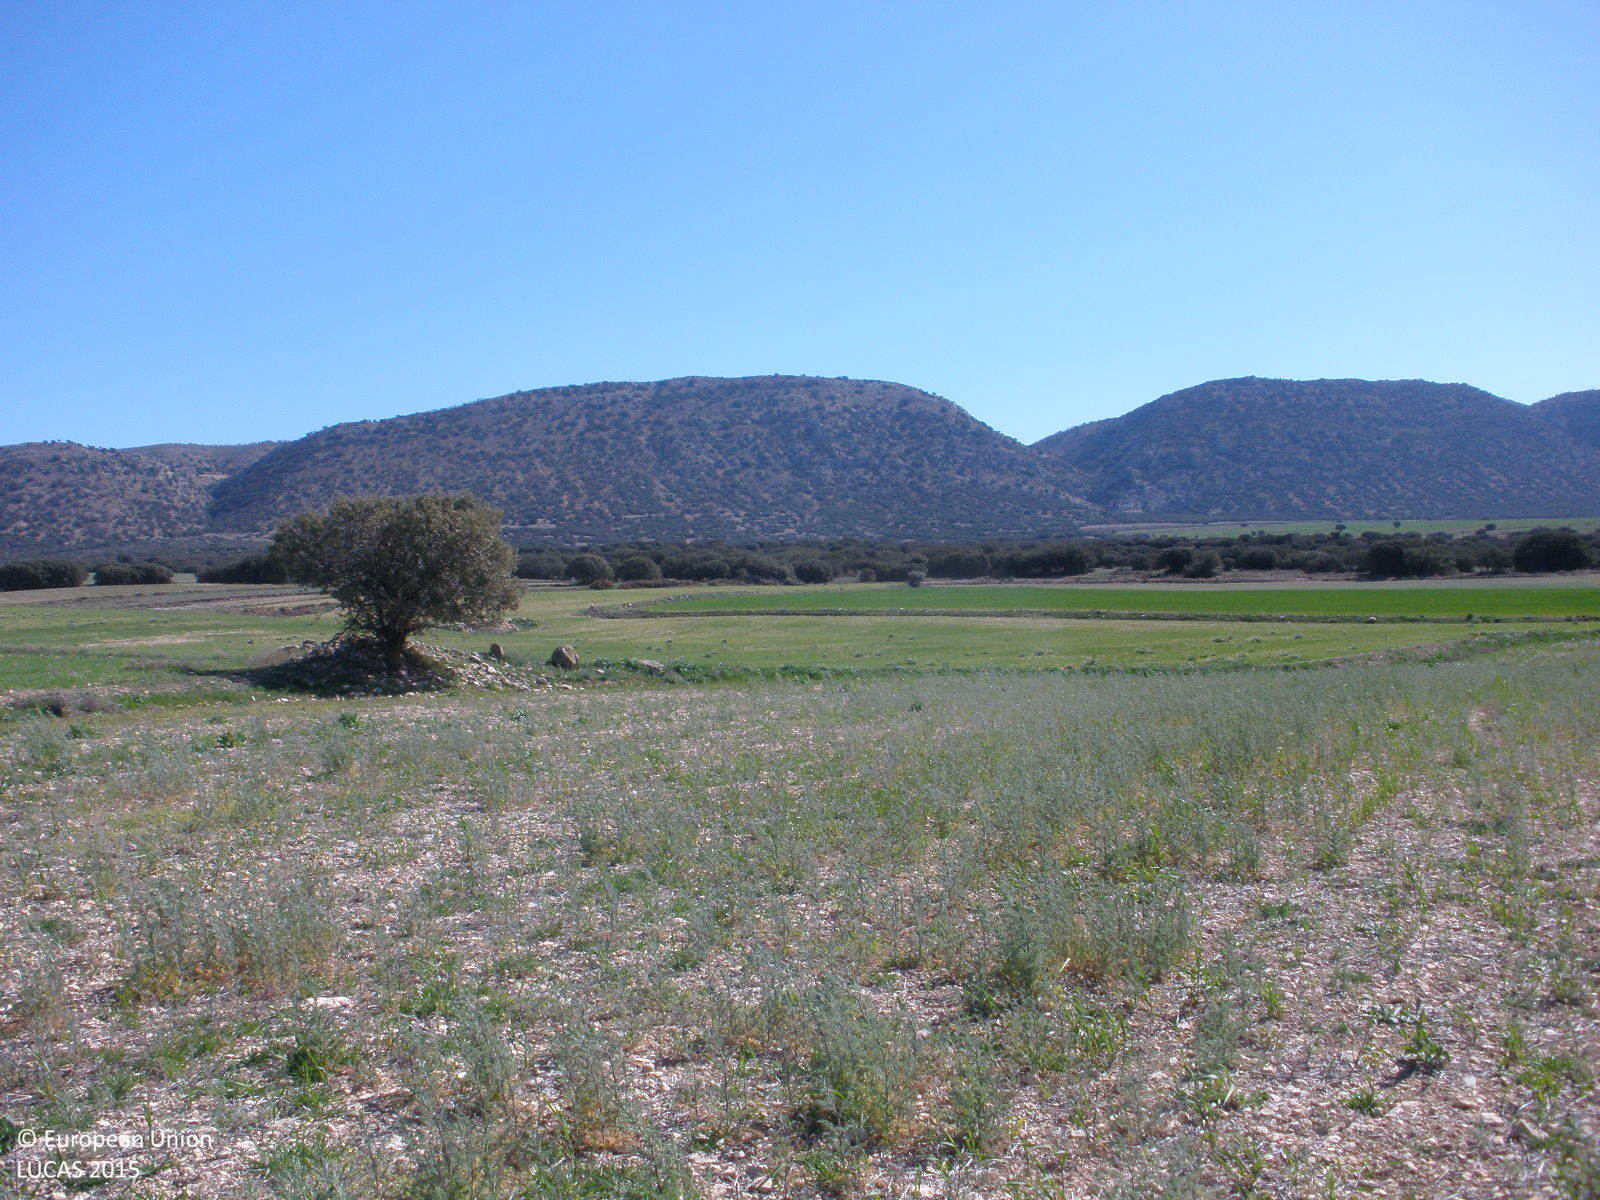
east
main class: Grassland
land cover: Spontaneously vegetated surfaces
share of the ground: 50 - 75 %
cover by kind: herbaceous plants 75 %, unconsolidated bare surface 25 %
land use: Agriculture (excluding fallow land and kitchen gardens)
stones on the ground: 25 - 50 %
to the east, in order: Spontaneously vegetated surfaces; Grass margins; Barley; Grass margins; Common wheat; Grass margins; Spontaneously vegetated surfaces
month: April
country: ES
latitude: 40.6897
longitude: -1.2926
